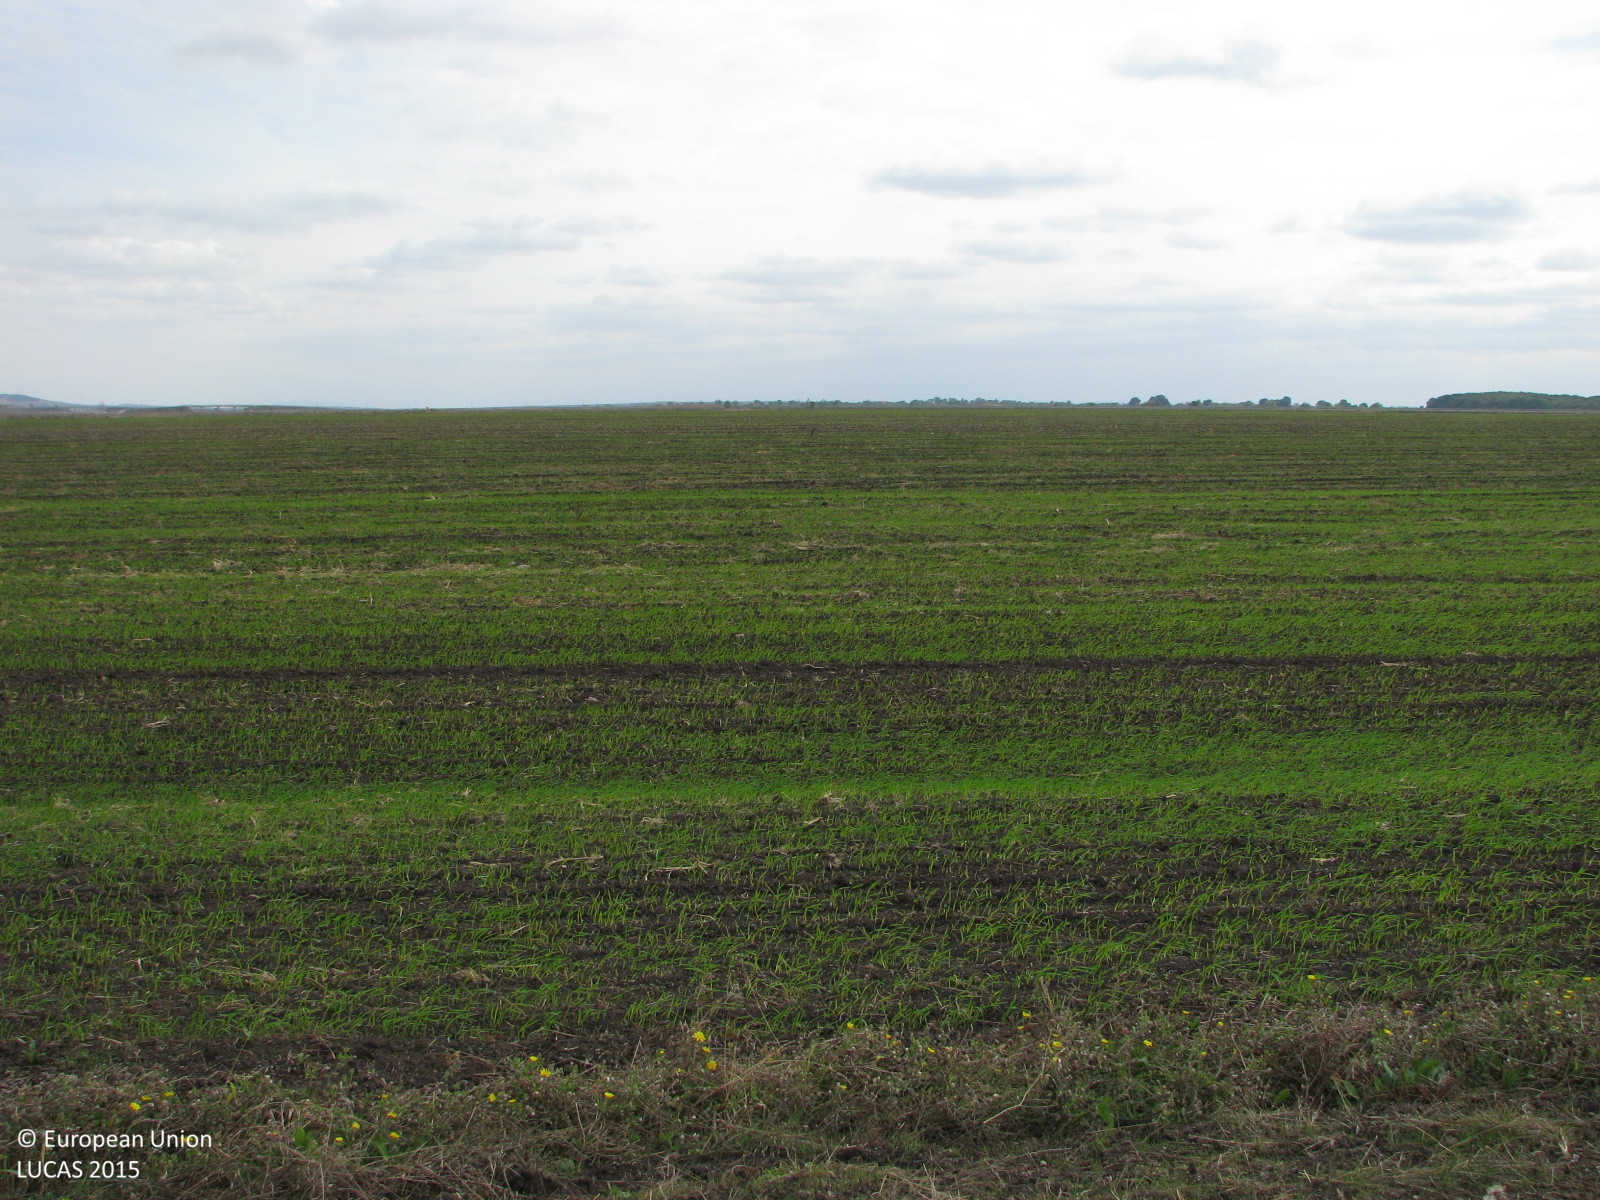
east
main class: Cropland
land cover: Sunflower
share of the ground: < 10 %
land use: Agriculture (excluding fallow land and kitchen gardens)
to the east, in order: Sunflower
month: October
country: BG
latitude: 42.4866
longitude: 26.1553
